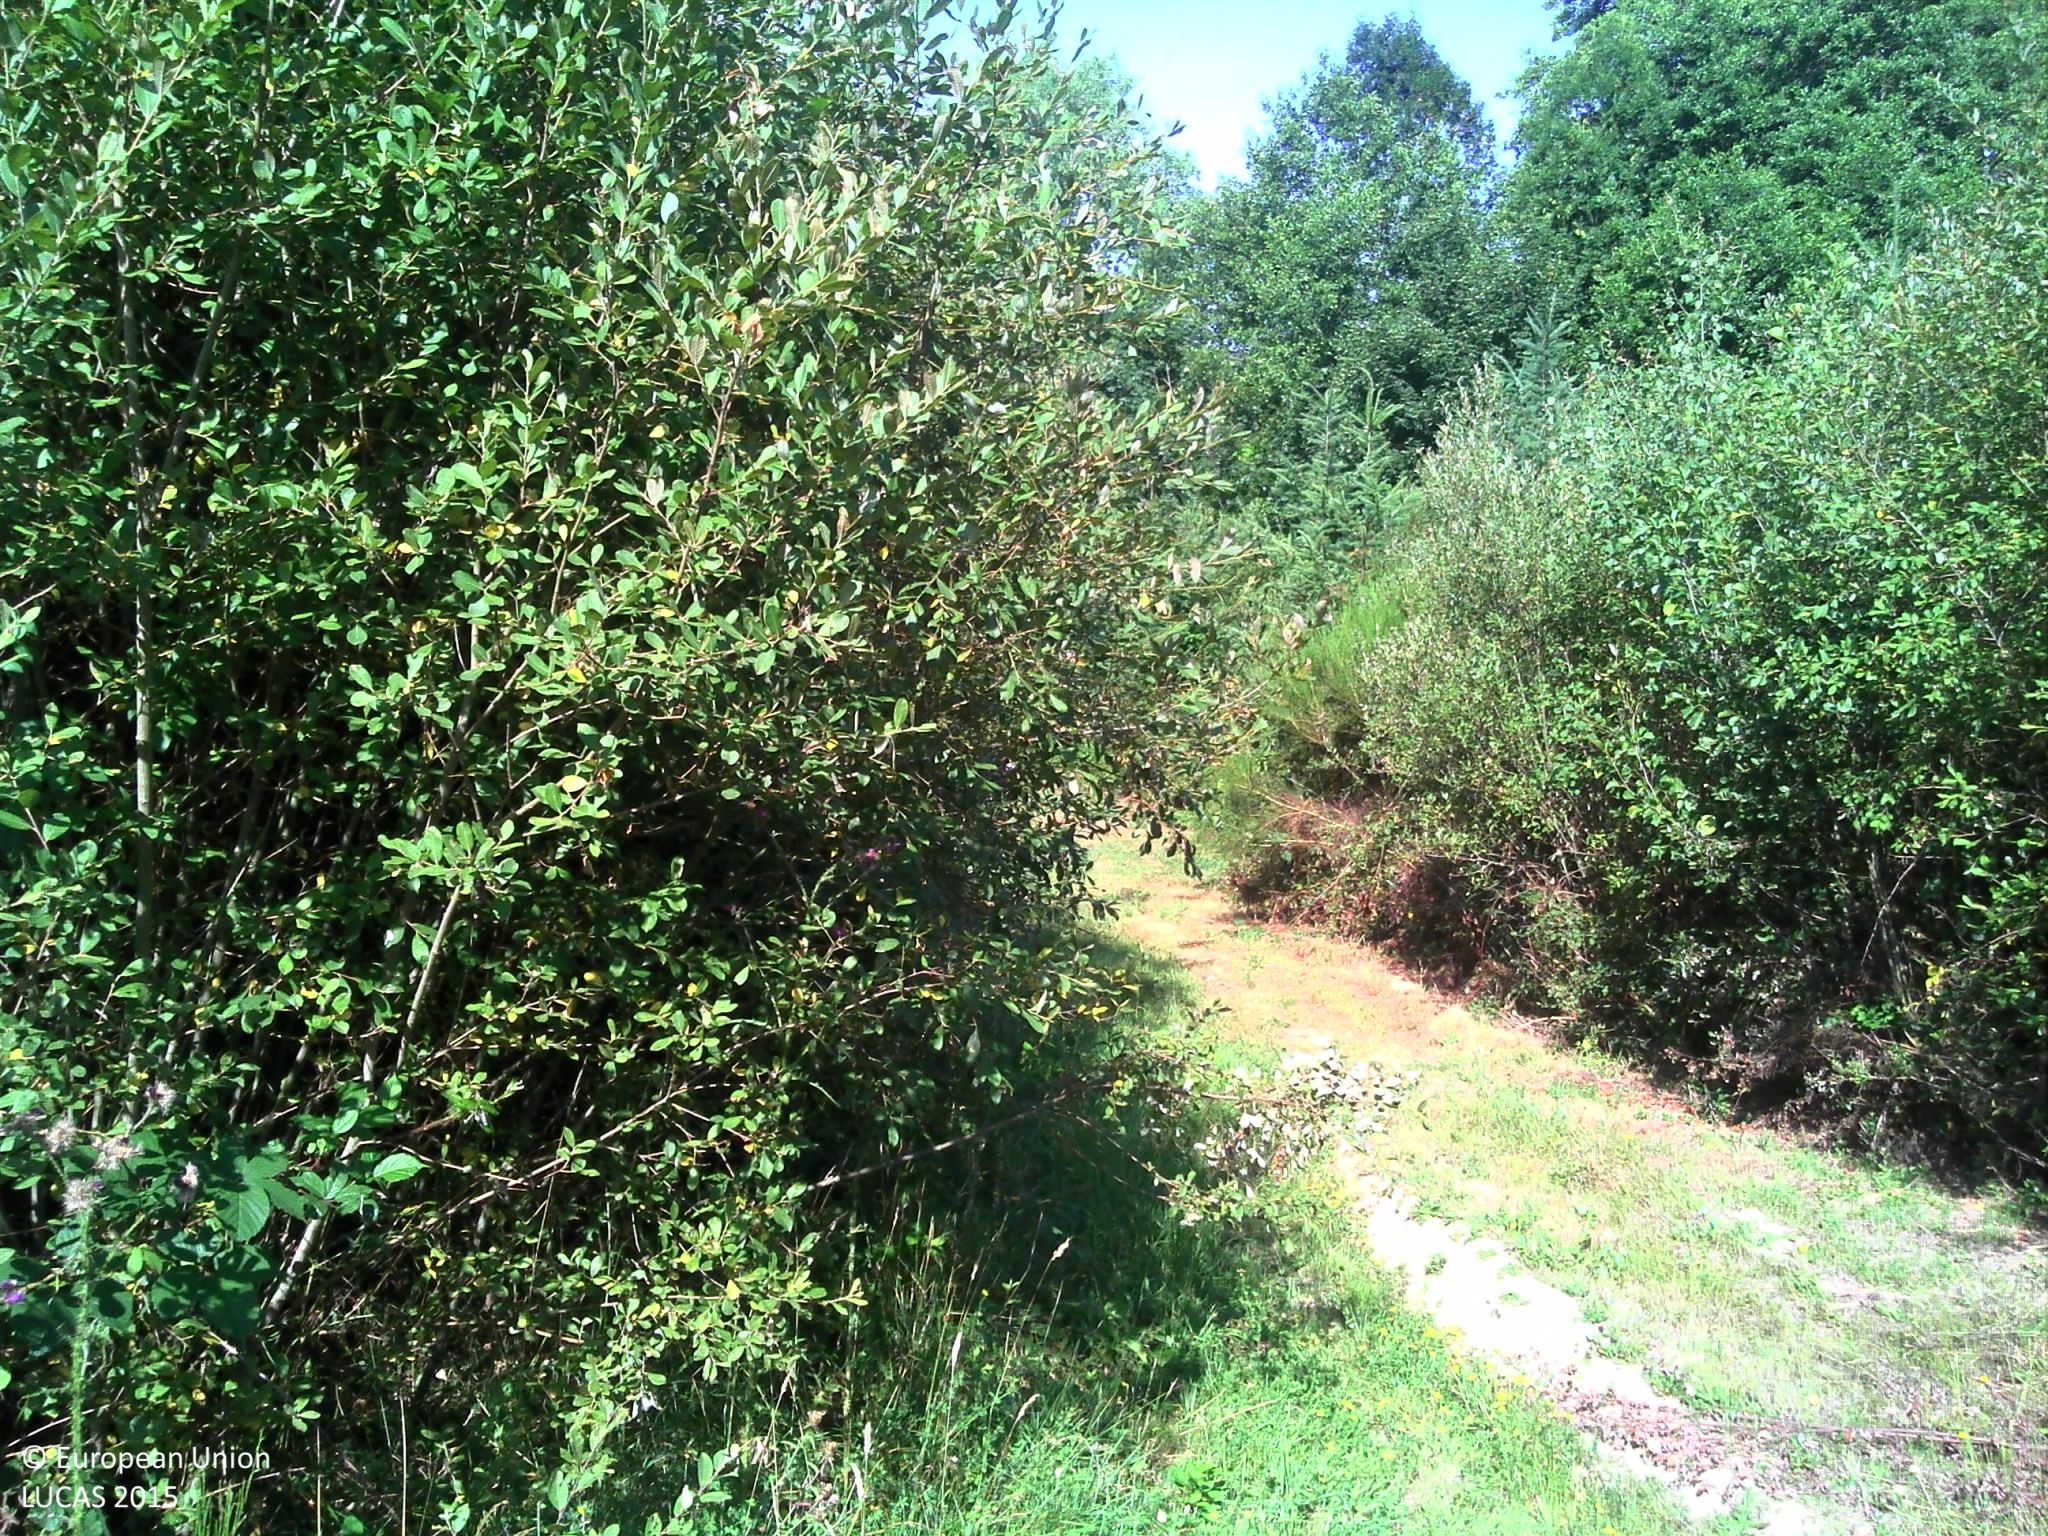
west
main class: Woodland
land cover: Pine dominated coniferous woodland
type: hemiboreal forest and nemoral coniferous forest and mixed broadleaved-coniferous forest
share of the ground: > 75 %
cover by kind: coniferous forest trees 75 %, broadleaved forest trees 25 %
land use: Forestry
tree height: > 5 m
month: July
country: FR
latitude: 45.9973
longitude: 1.7683
